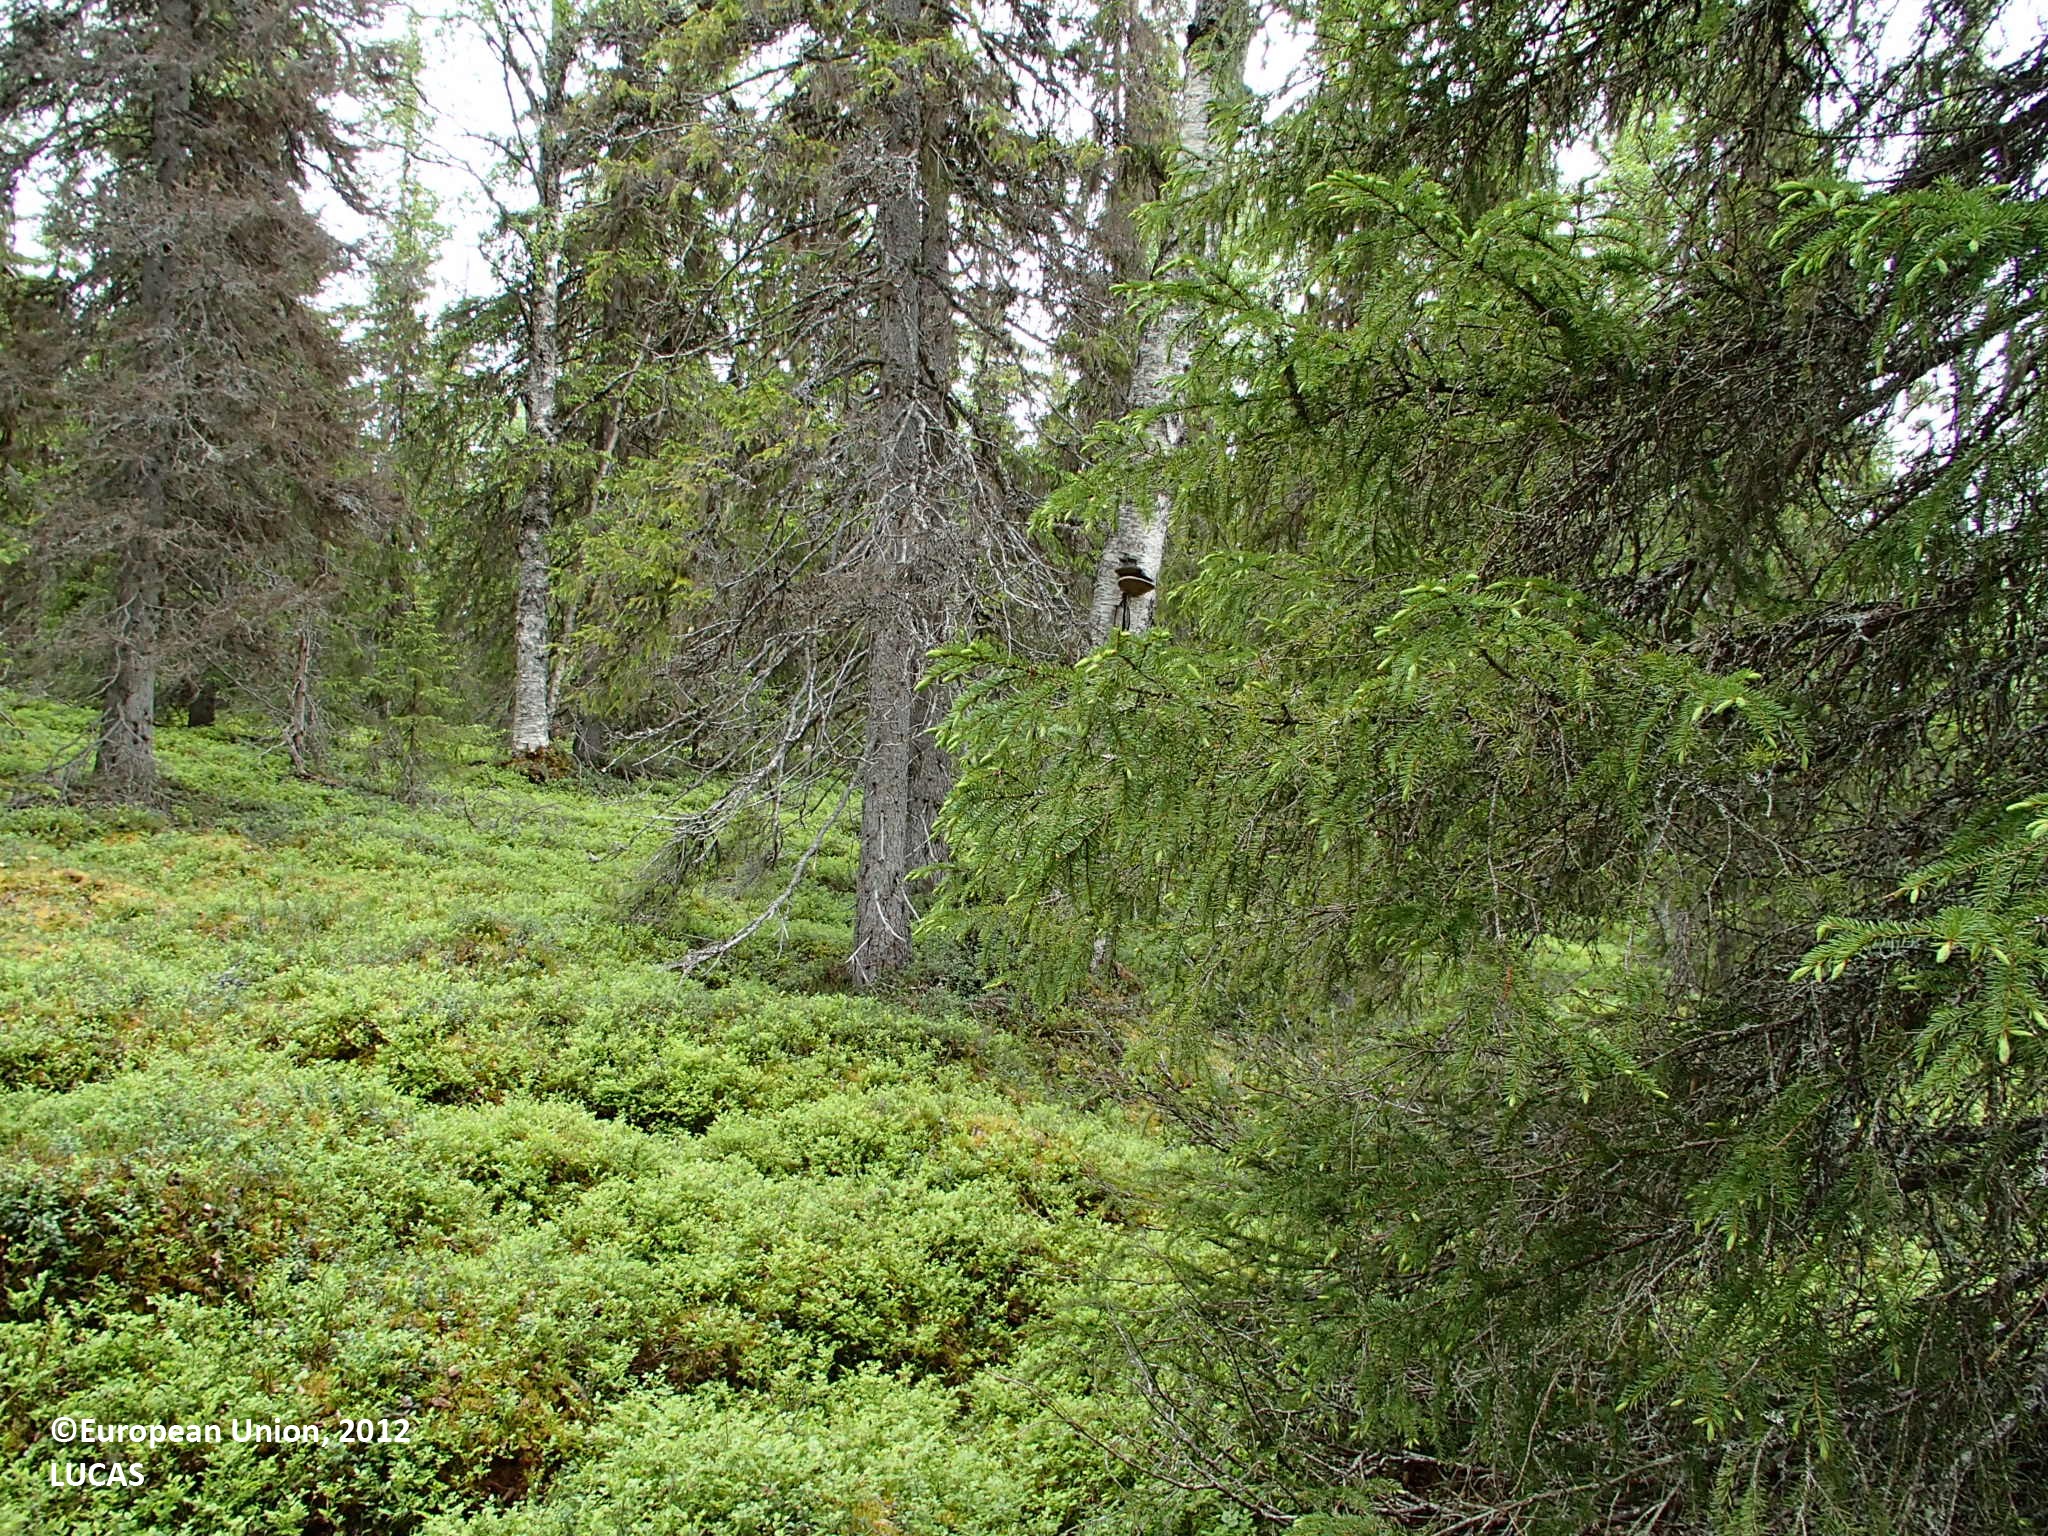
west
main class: Woodland
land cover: Spruce dominated mixed woodland
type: boreal forest
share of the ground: > 75 %
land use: Forestry
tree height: > 5 m
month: June
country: FI
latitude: 66.4421
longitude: 27.5844
